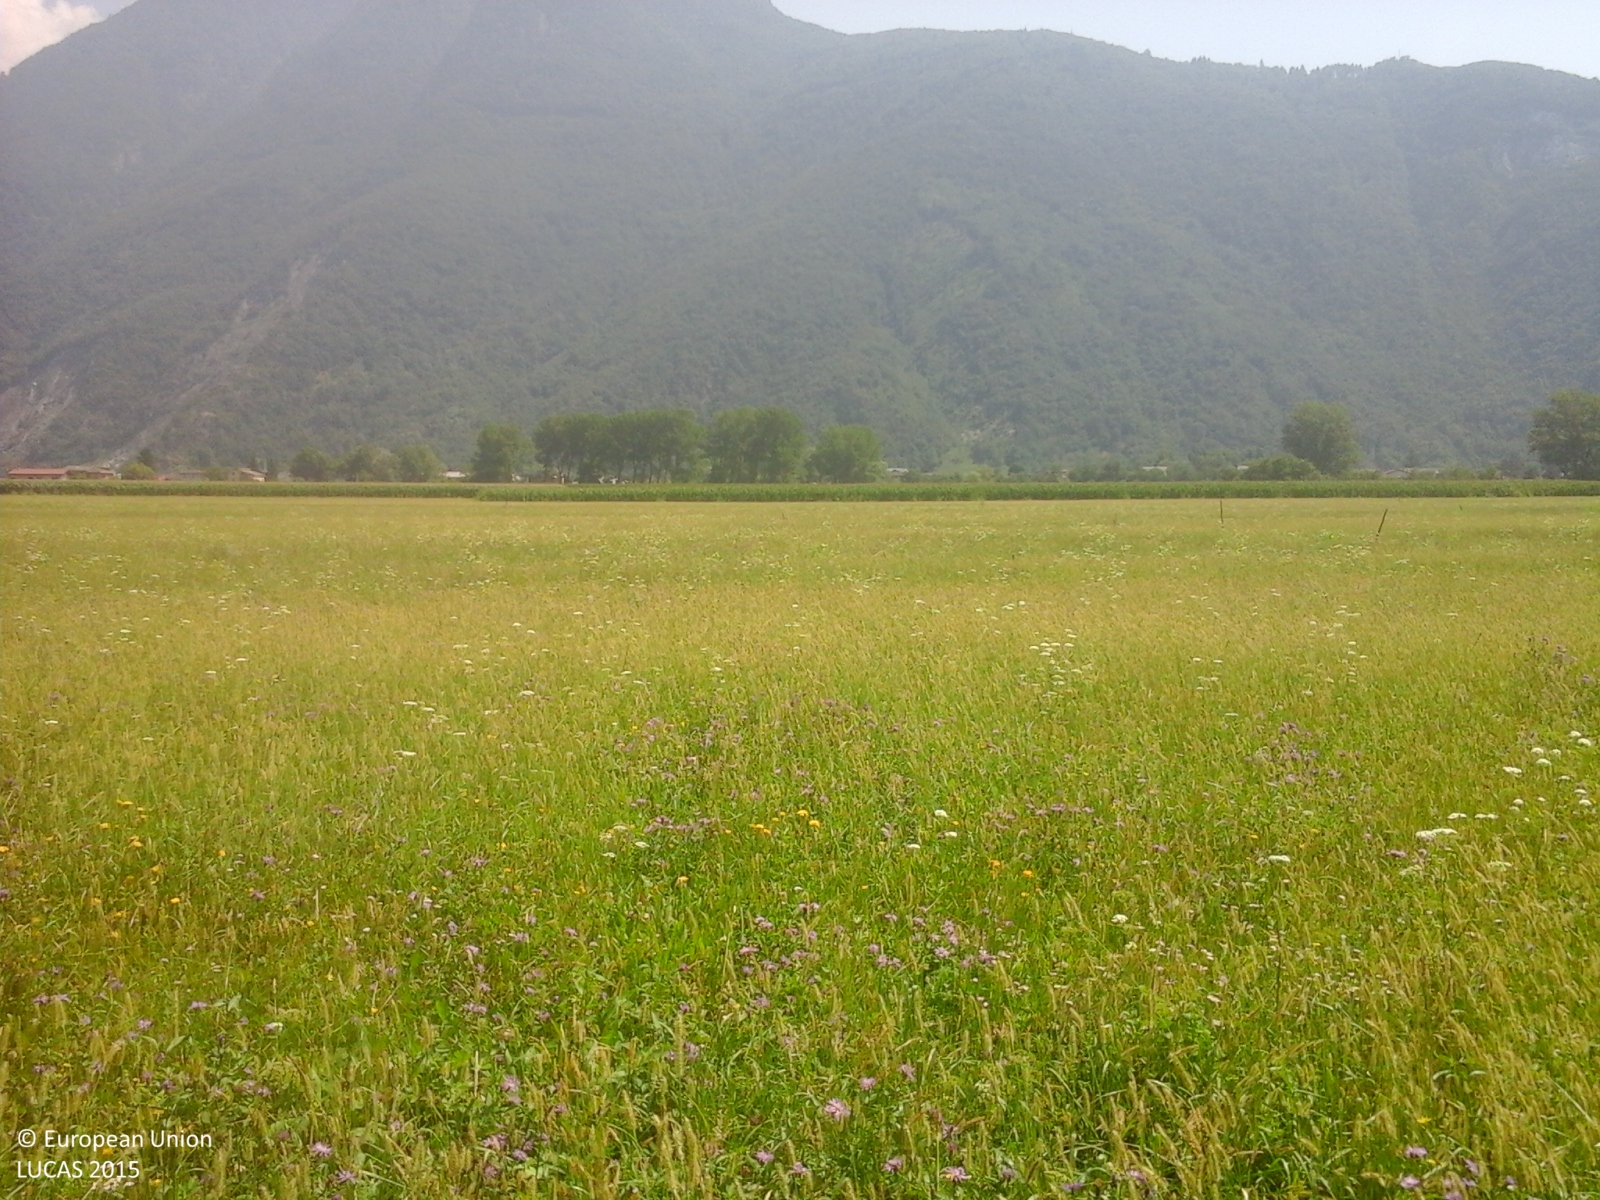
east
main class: Grassland
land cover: Grassland without tree/shrub cover
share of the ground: > 75 %
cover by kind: herbaceous plants 100 %
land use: Agriculture (excluding fallow land and kitchen gardens)
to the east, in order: Grassland without tree/shrub cover; Maize; Grassland without tree/shrub cover
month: August
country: IT
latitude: 46.1695
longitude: 9.4180
